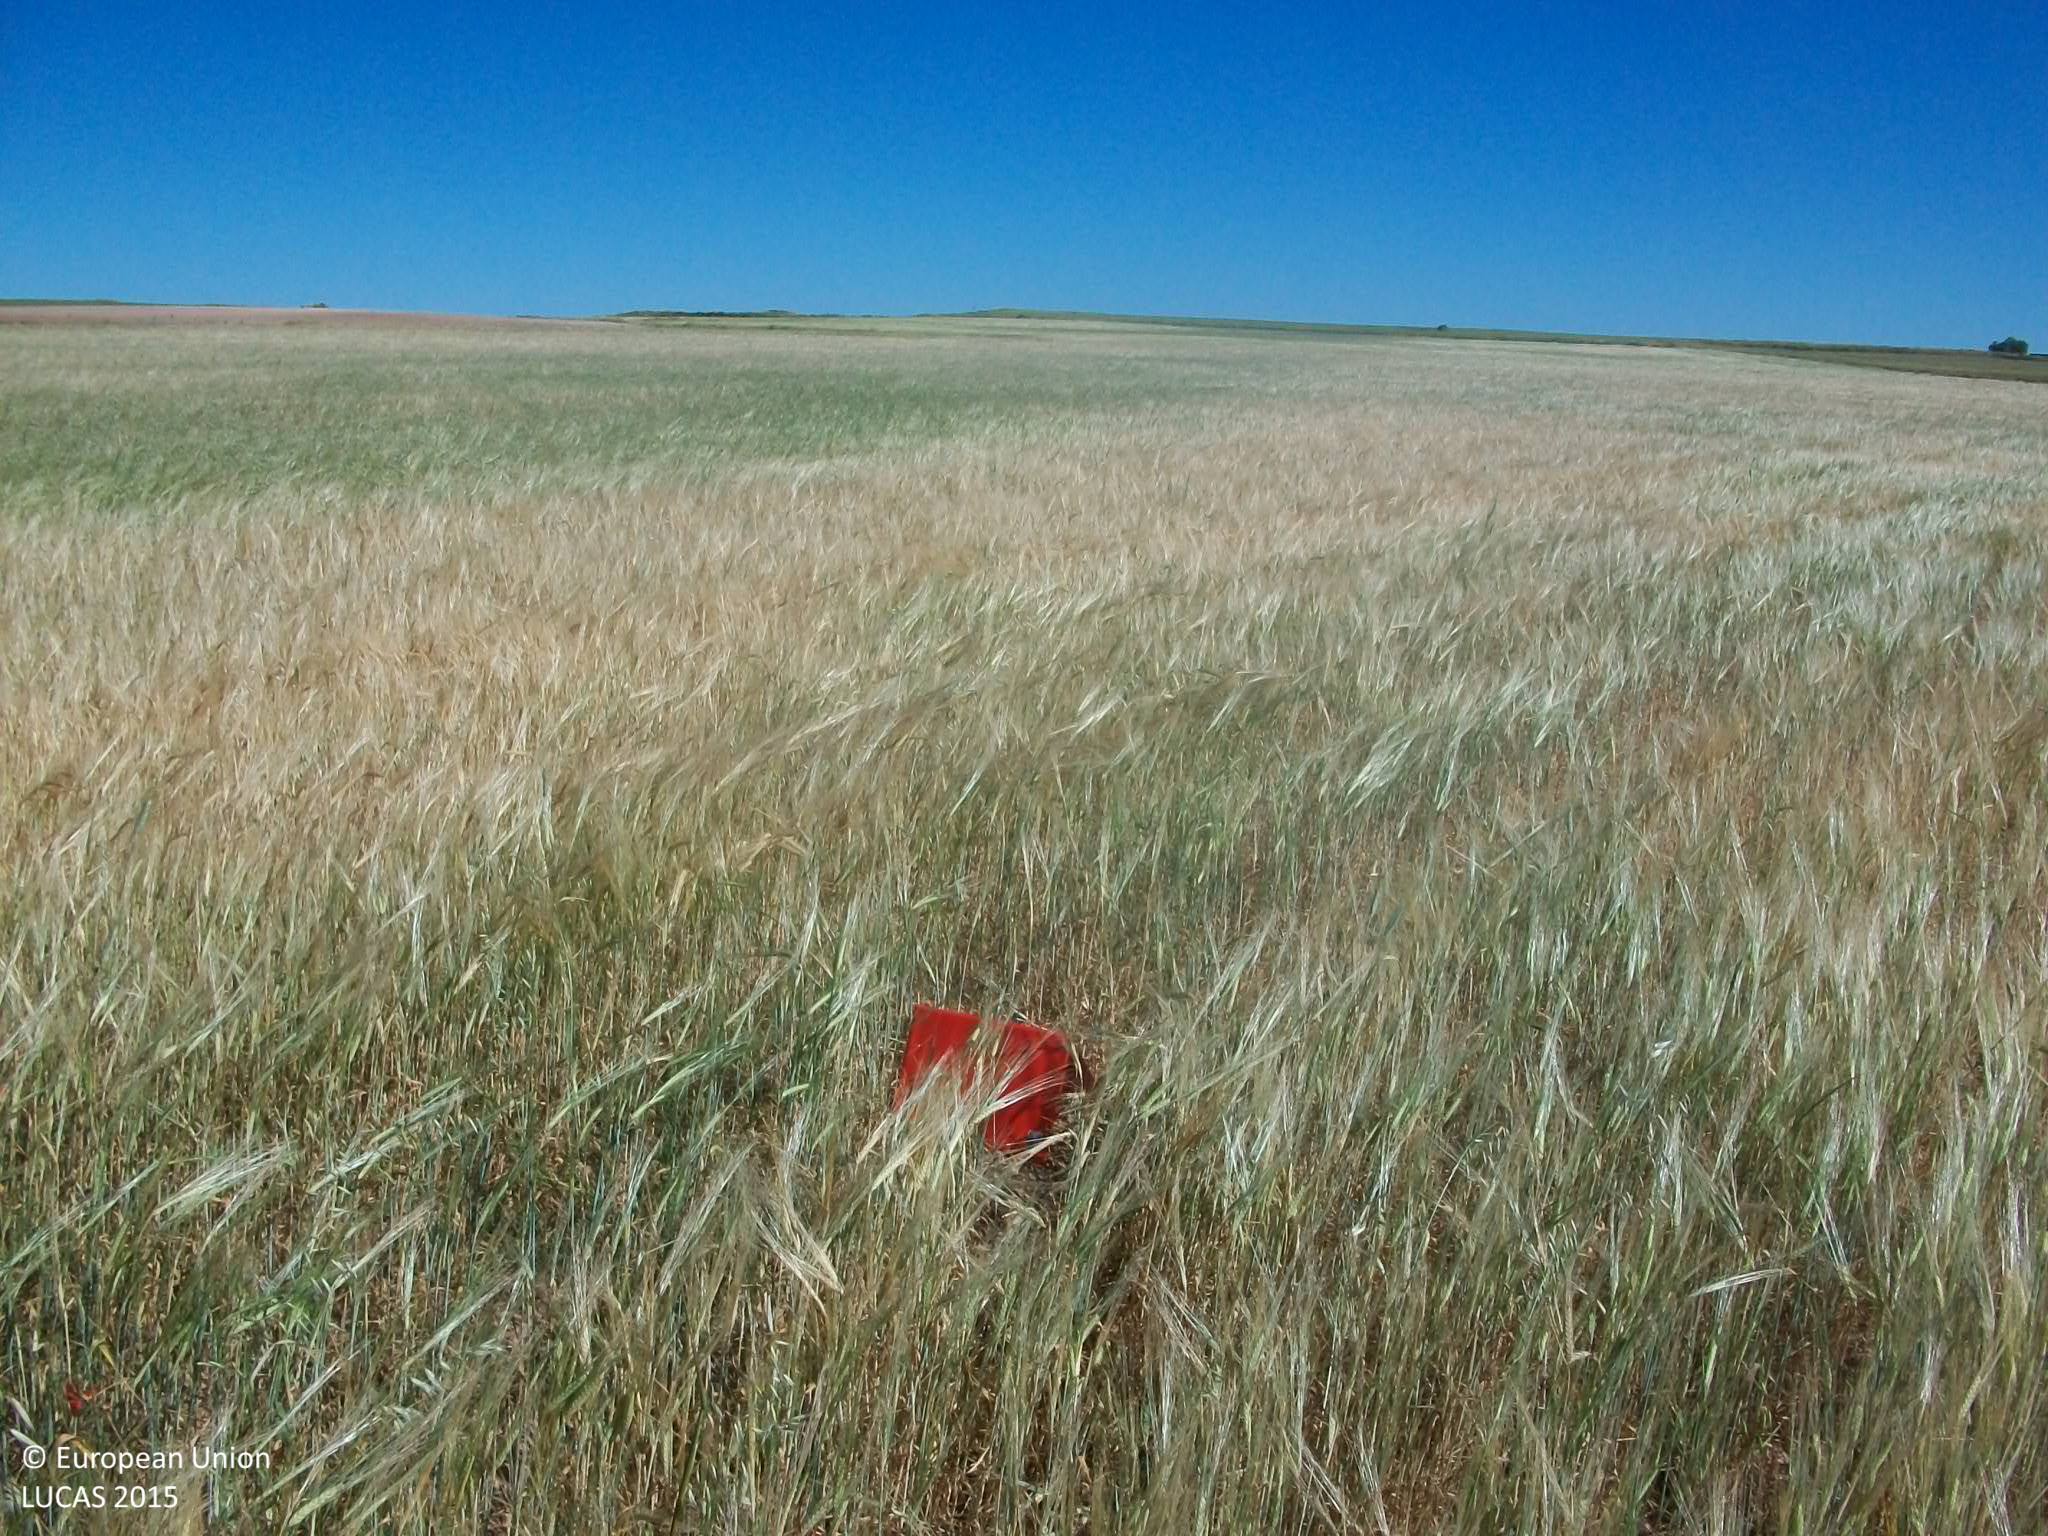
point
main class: Cropland
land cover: Barley
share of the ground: > 75 %
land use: Agriculture (excluding fallow land and kitchen gardens)
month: May
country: ES
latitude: 39.7774
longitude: -3.4409
